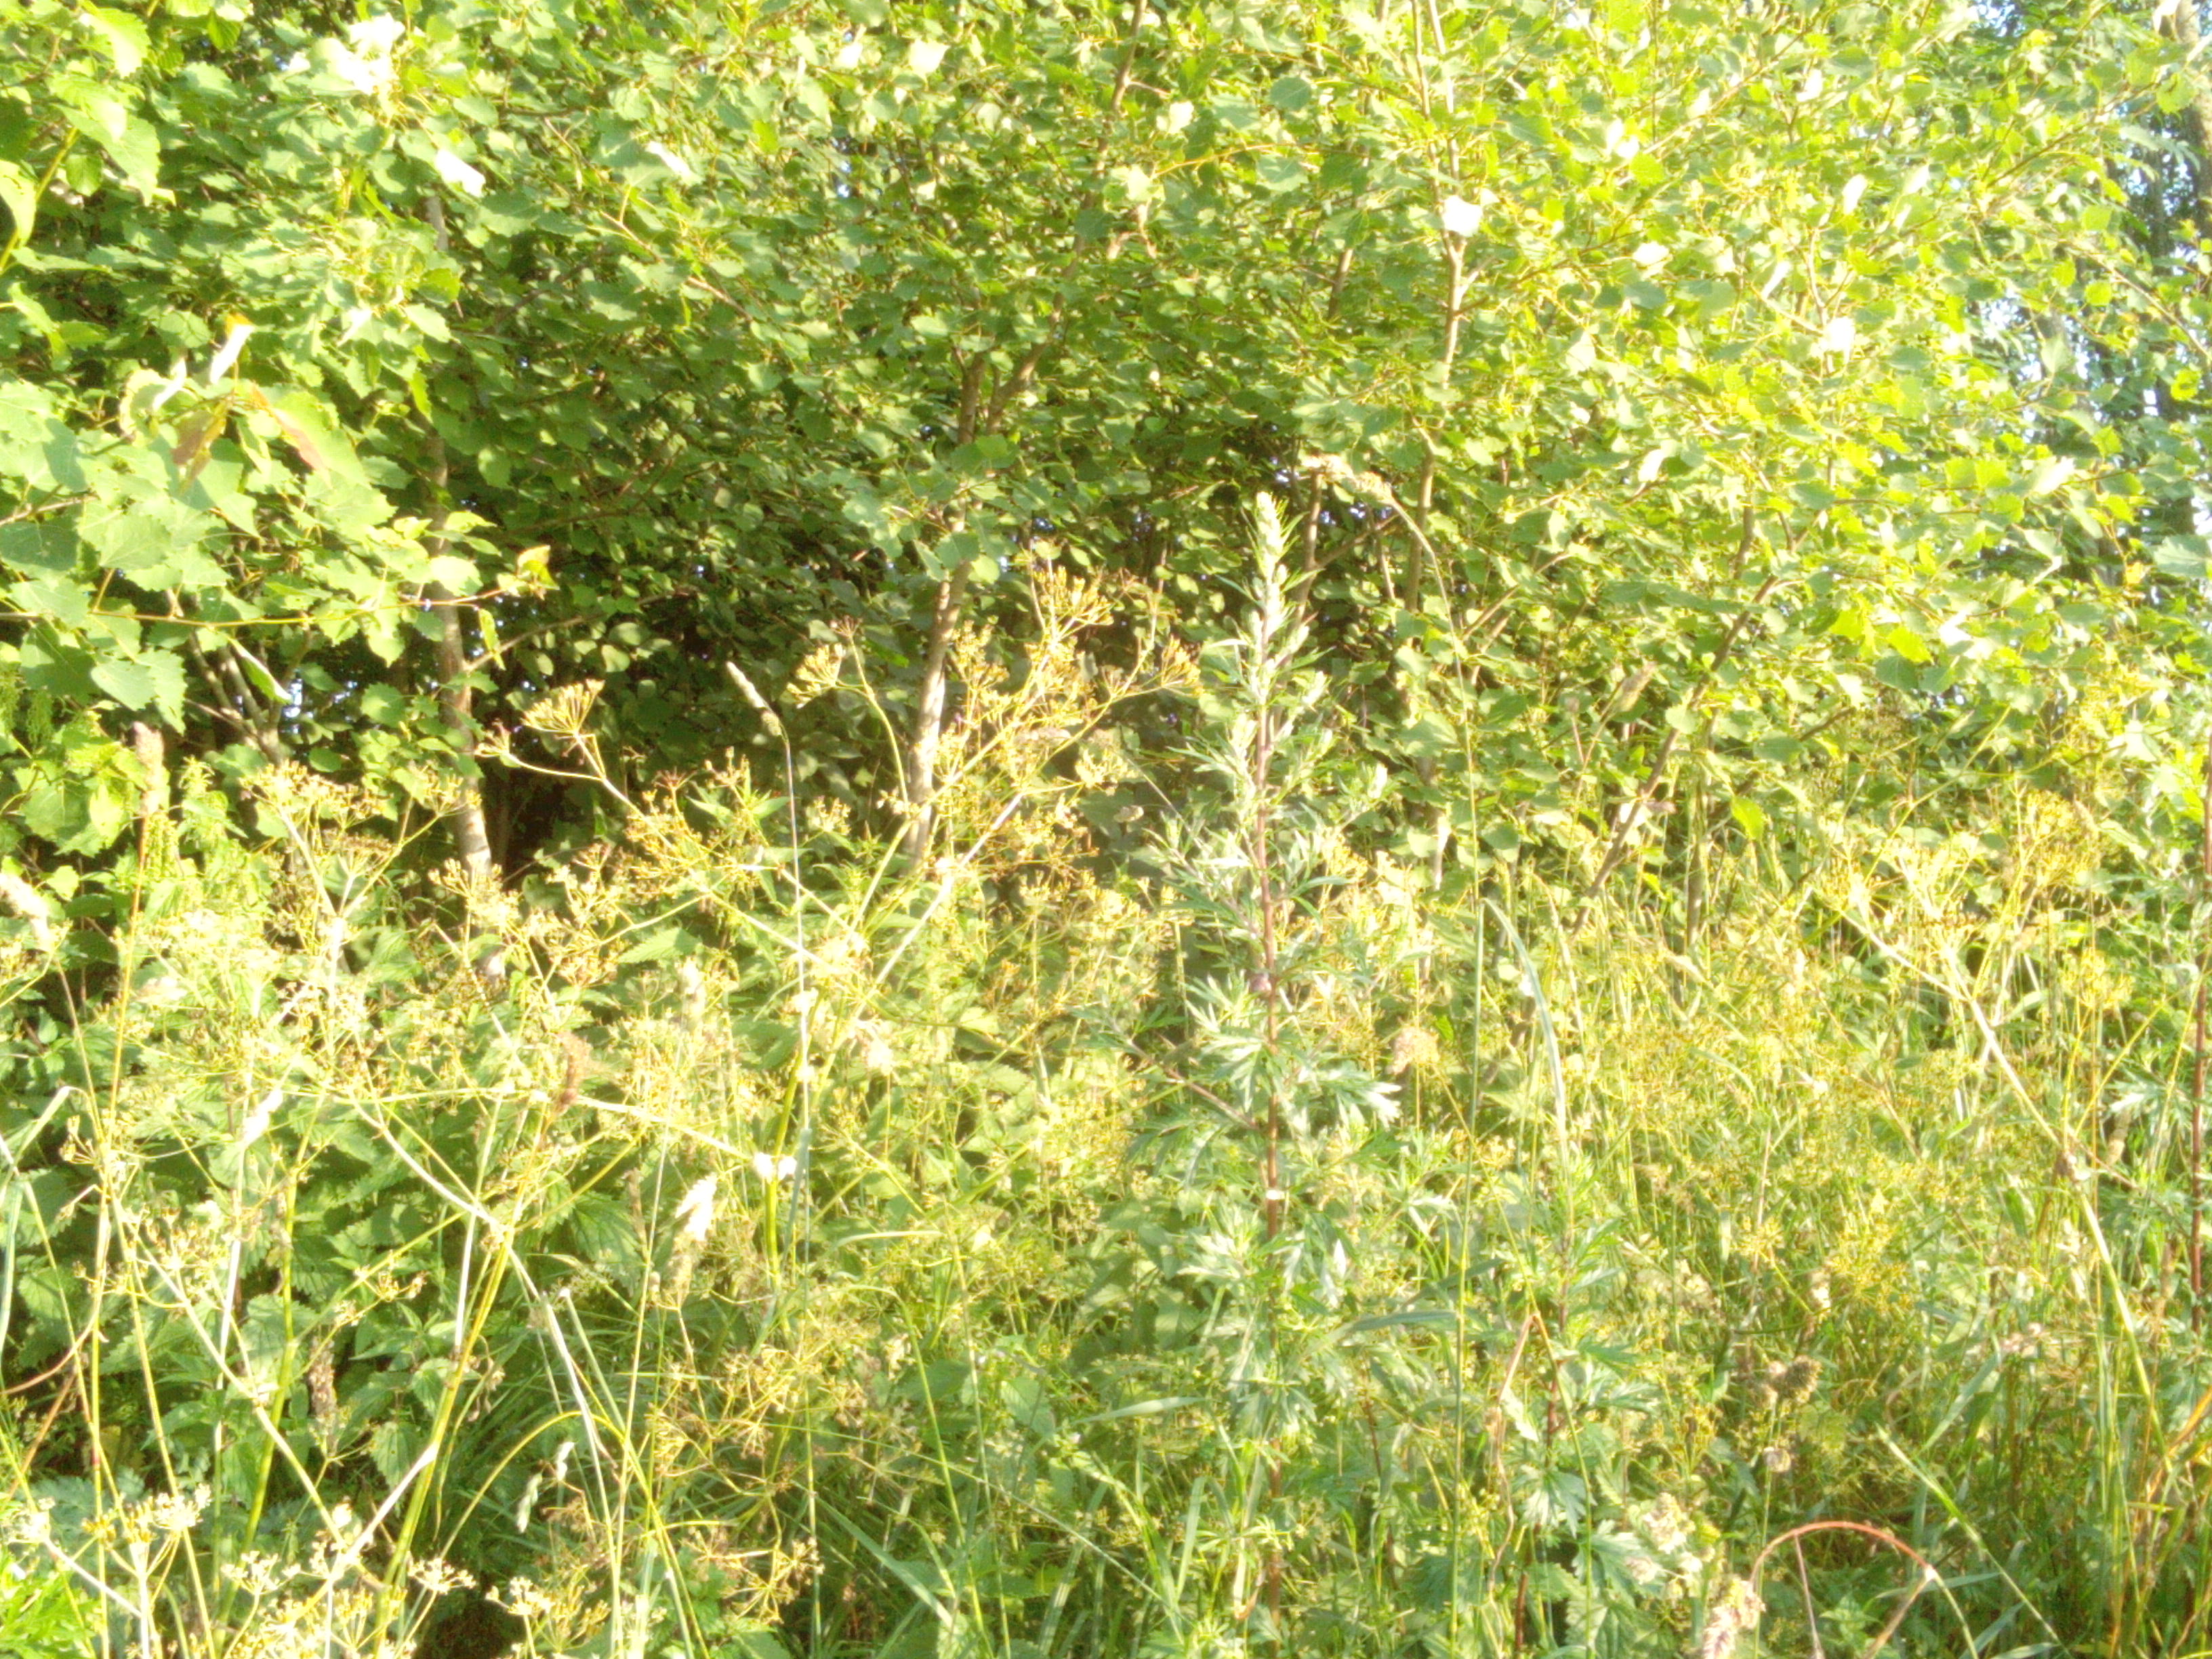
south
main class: Cropland
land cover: Rape and turnip rape
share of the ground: > 75 %
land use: Agriculture (excluding fallow land and kitchen gardens)
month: July
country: LV
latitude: 56.3790
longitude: 21.6886
